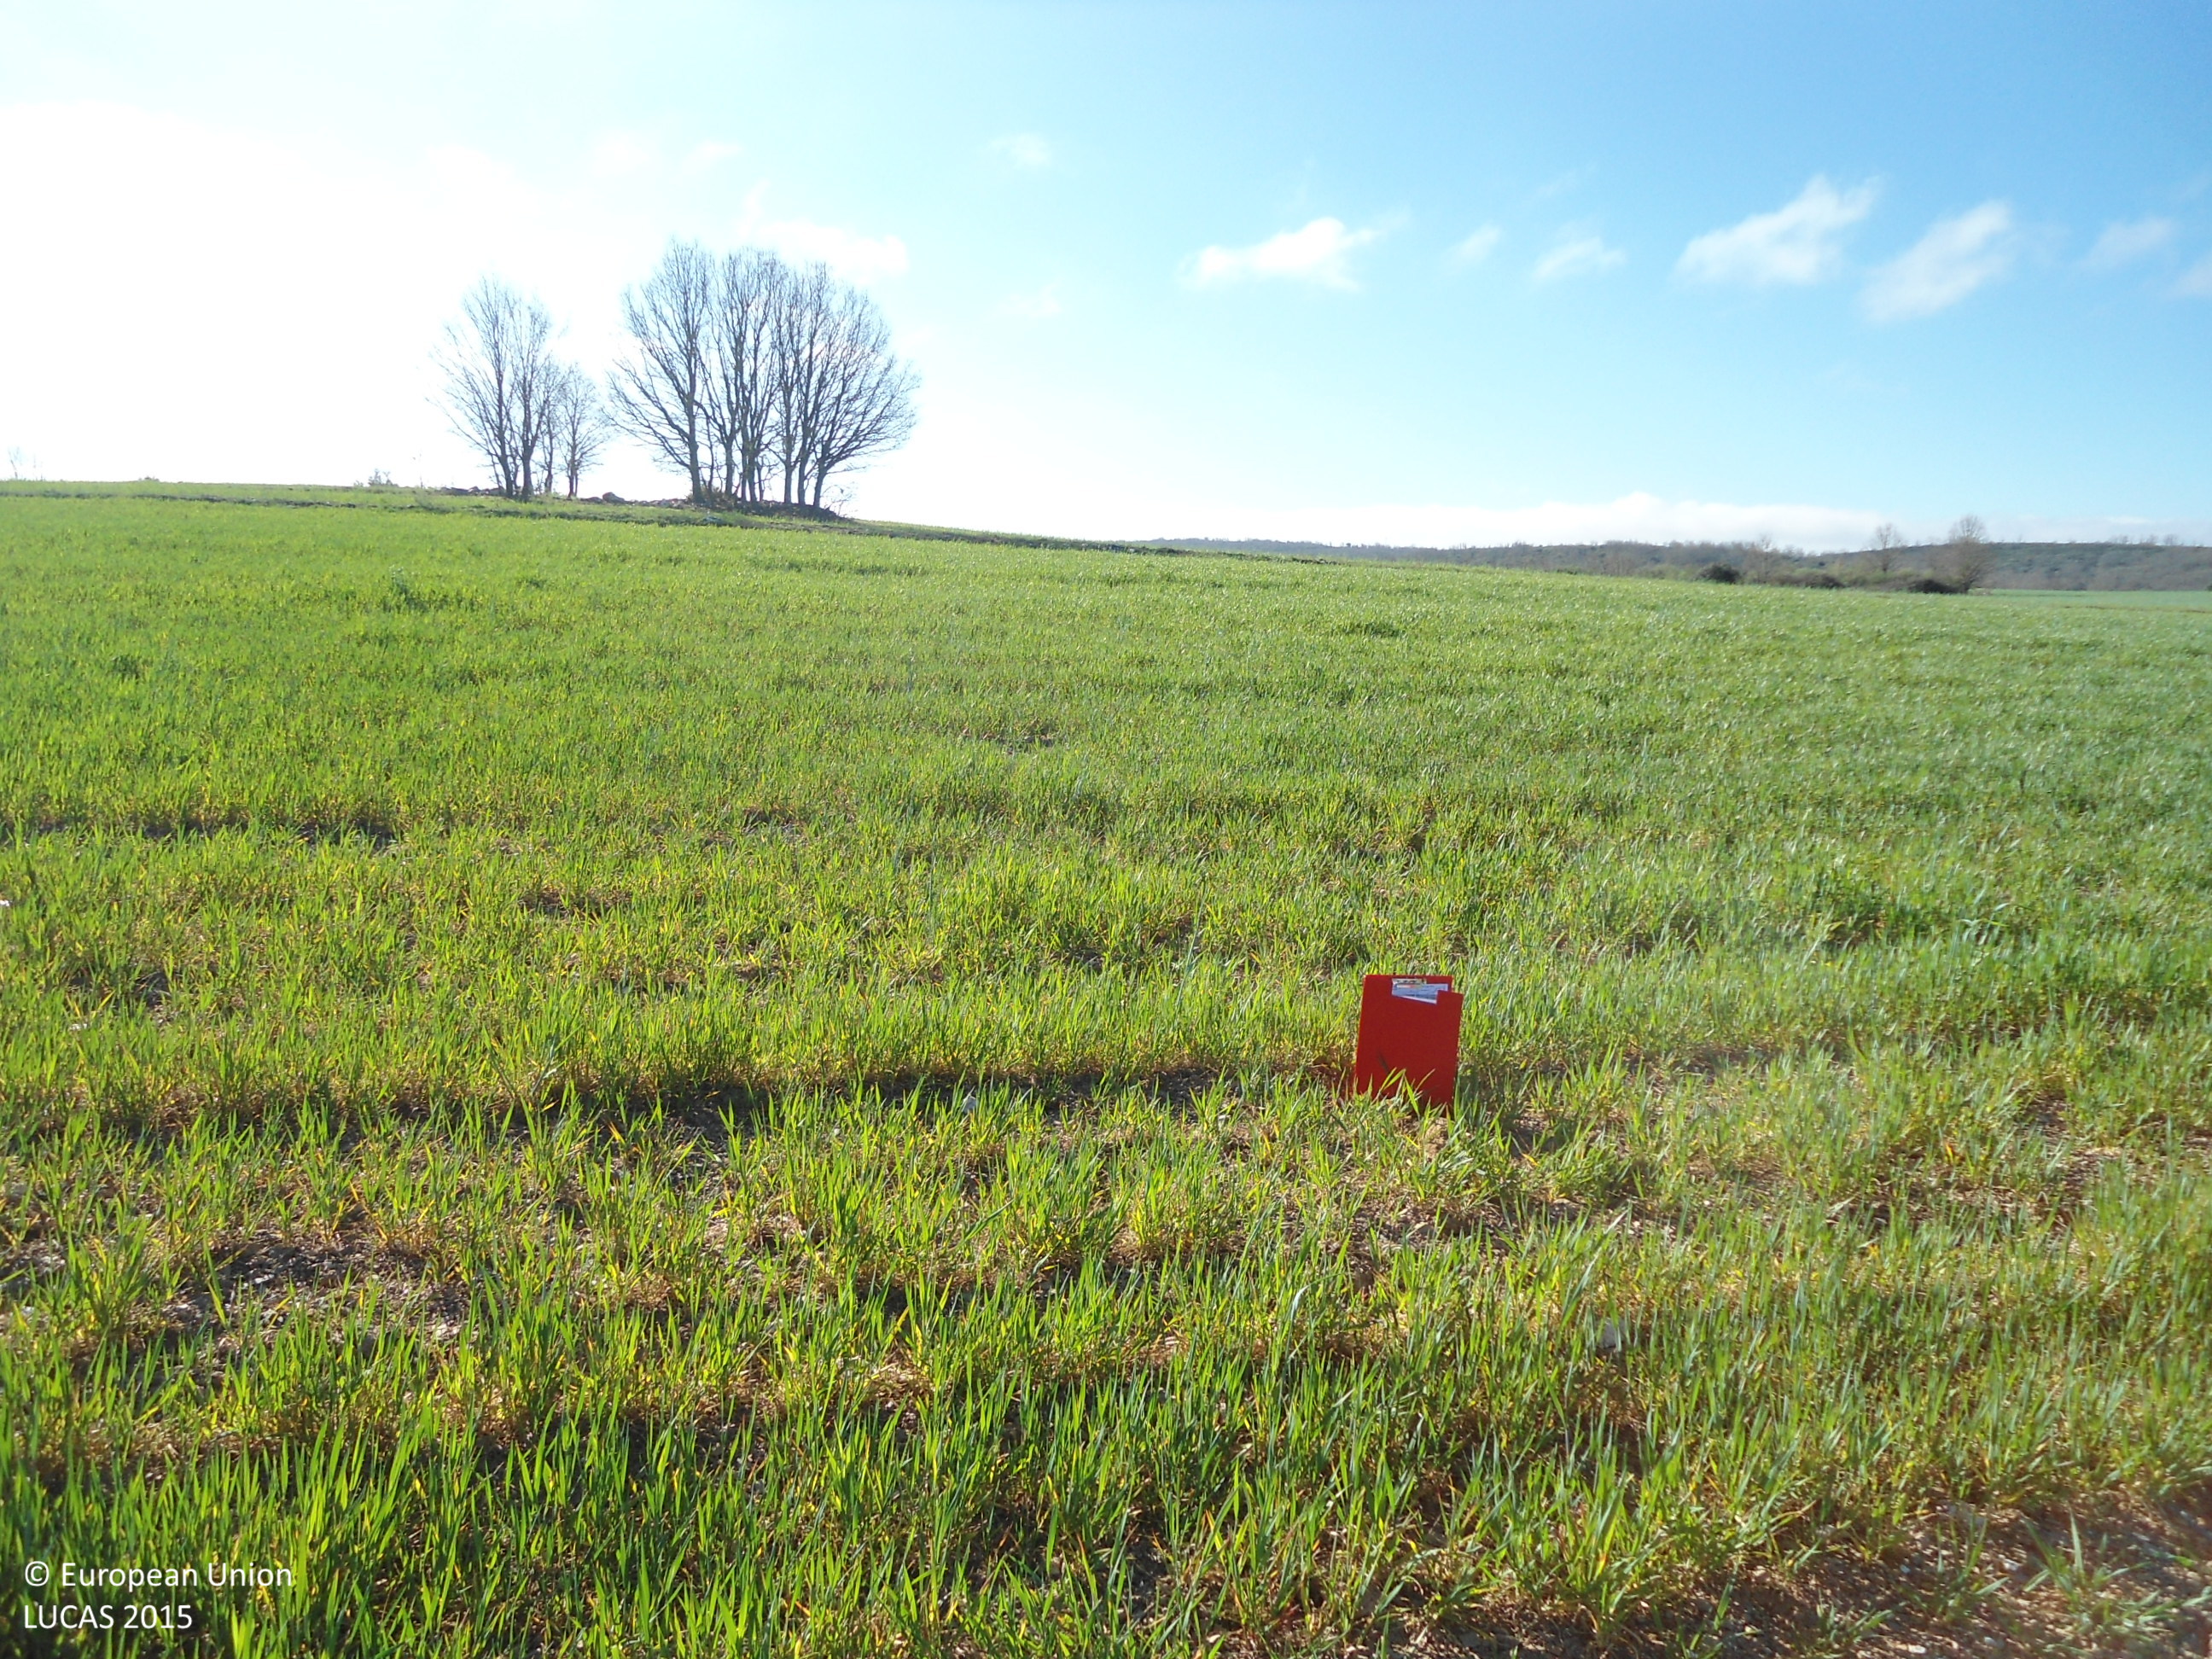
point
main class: Cropland
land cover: Common wheat
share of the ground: > 75 %
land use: Agriculture (excluding fallow land and kitchen gardens)
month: April
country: ES
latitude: 41.6638
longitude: -6.1298
